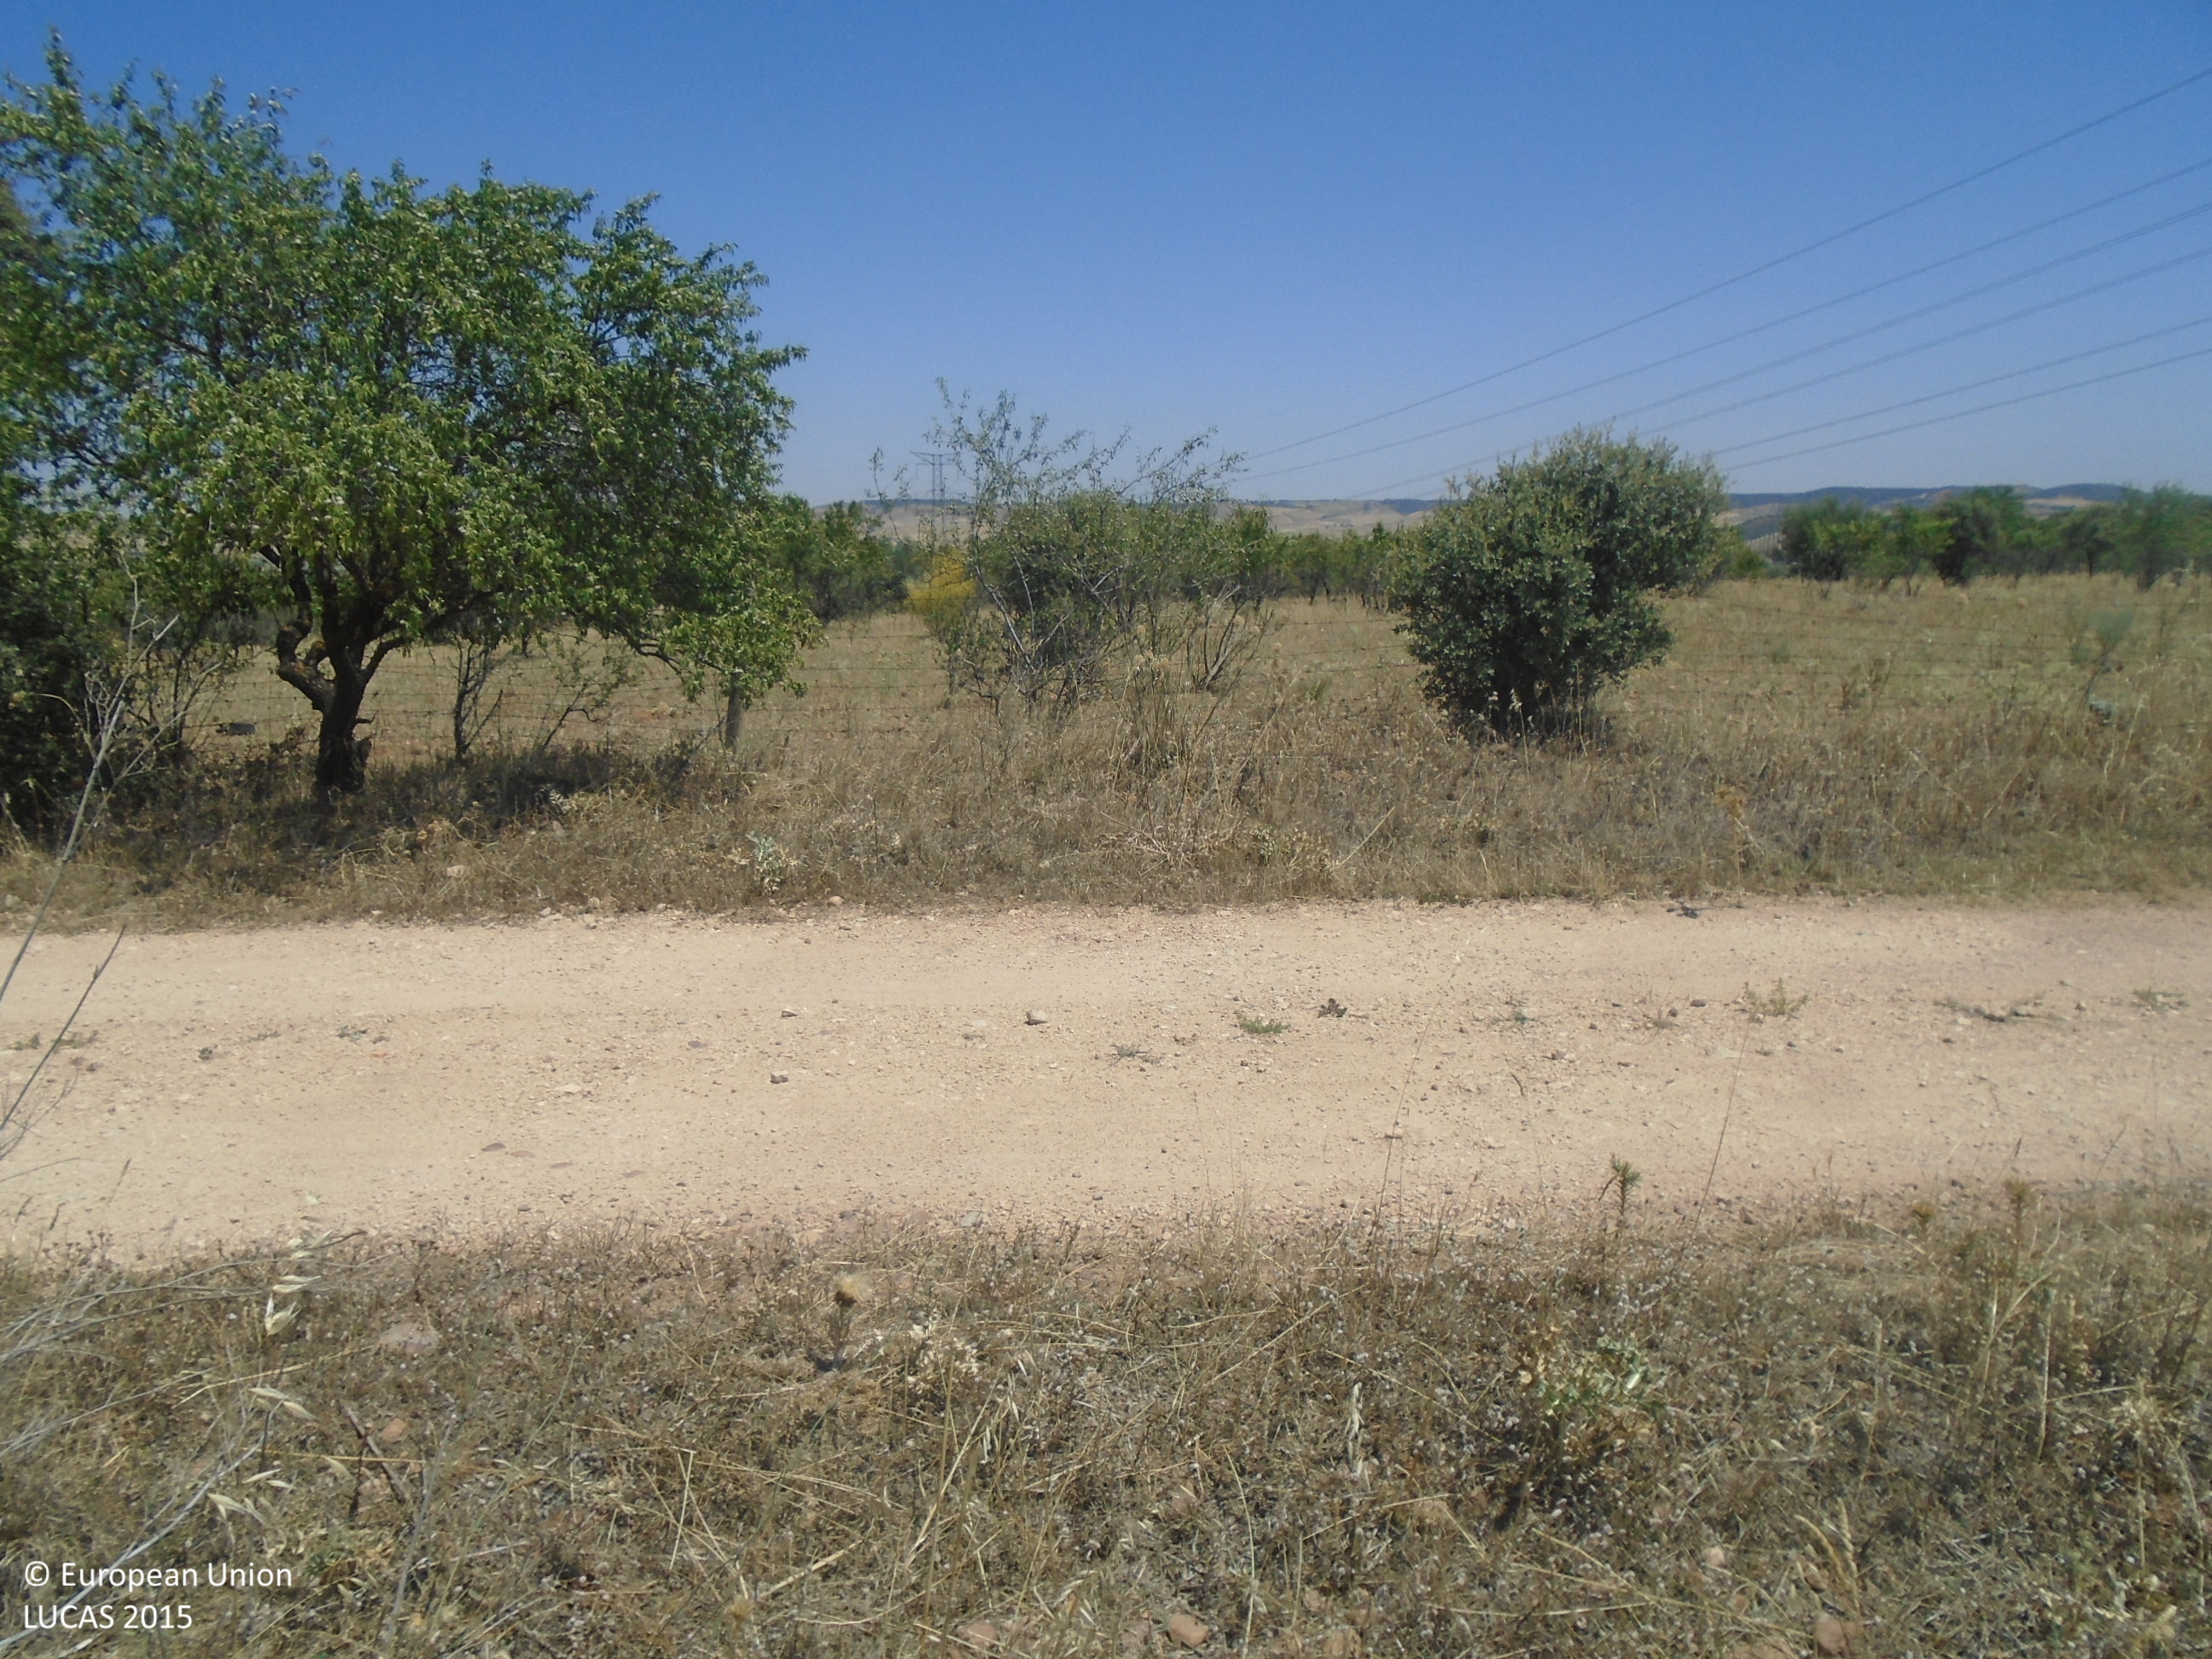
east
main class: Cropland
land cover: Barley
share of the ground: > 75 %
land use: Agriculture (excluding fallow land and kitchen gardens)
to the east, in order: Barley; Grass margins; Ditches and canals; Grass margins; Spontaneously vegetated surfaces; Grass margins; Rock outcrops; Grass margins; Fences; Grass margins; Tracks; Grass margins; Fences; Nuts trees
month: July
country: ES
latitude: 39.8032
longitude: -4.8915
